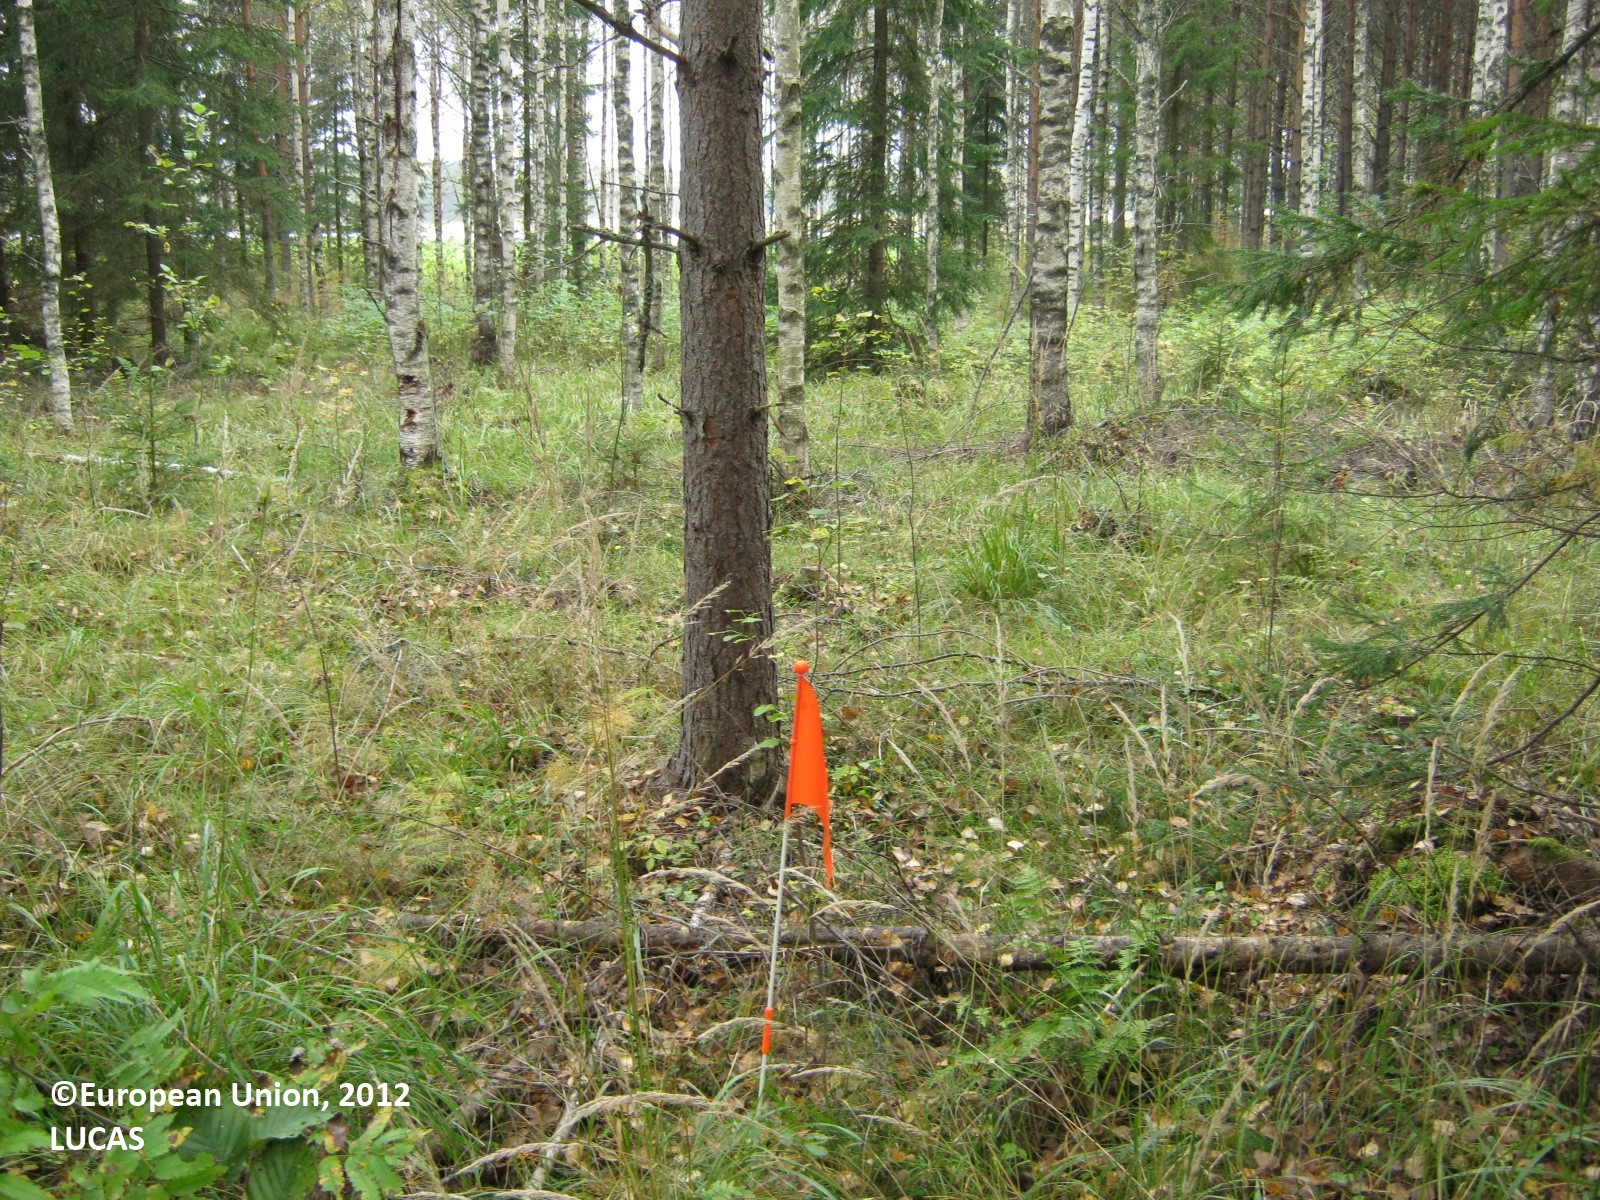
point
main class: Woodland
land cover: Other mixed woodland
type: boreal forest
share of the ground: > 75 %
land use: Forestry
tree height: > 5 m
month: September
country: FI
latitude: 61.0047
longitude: 28.0468
